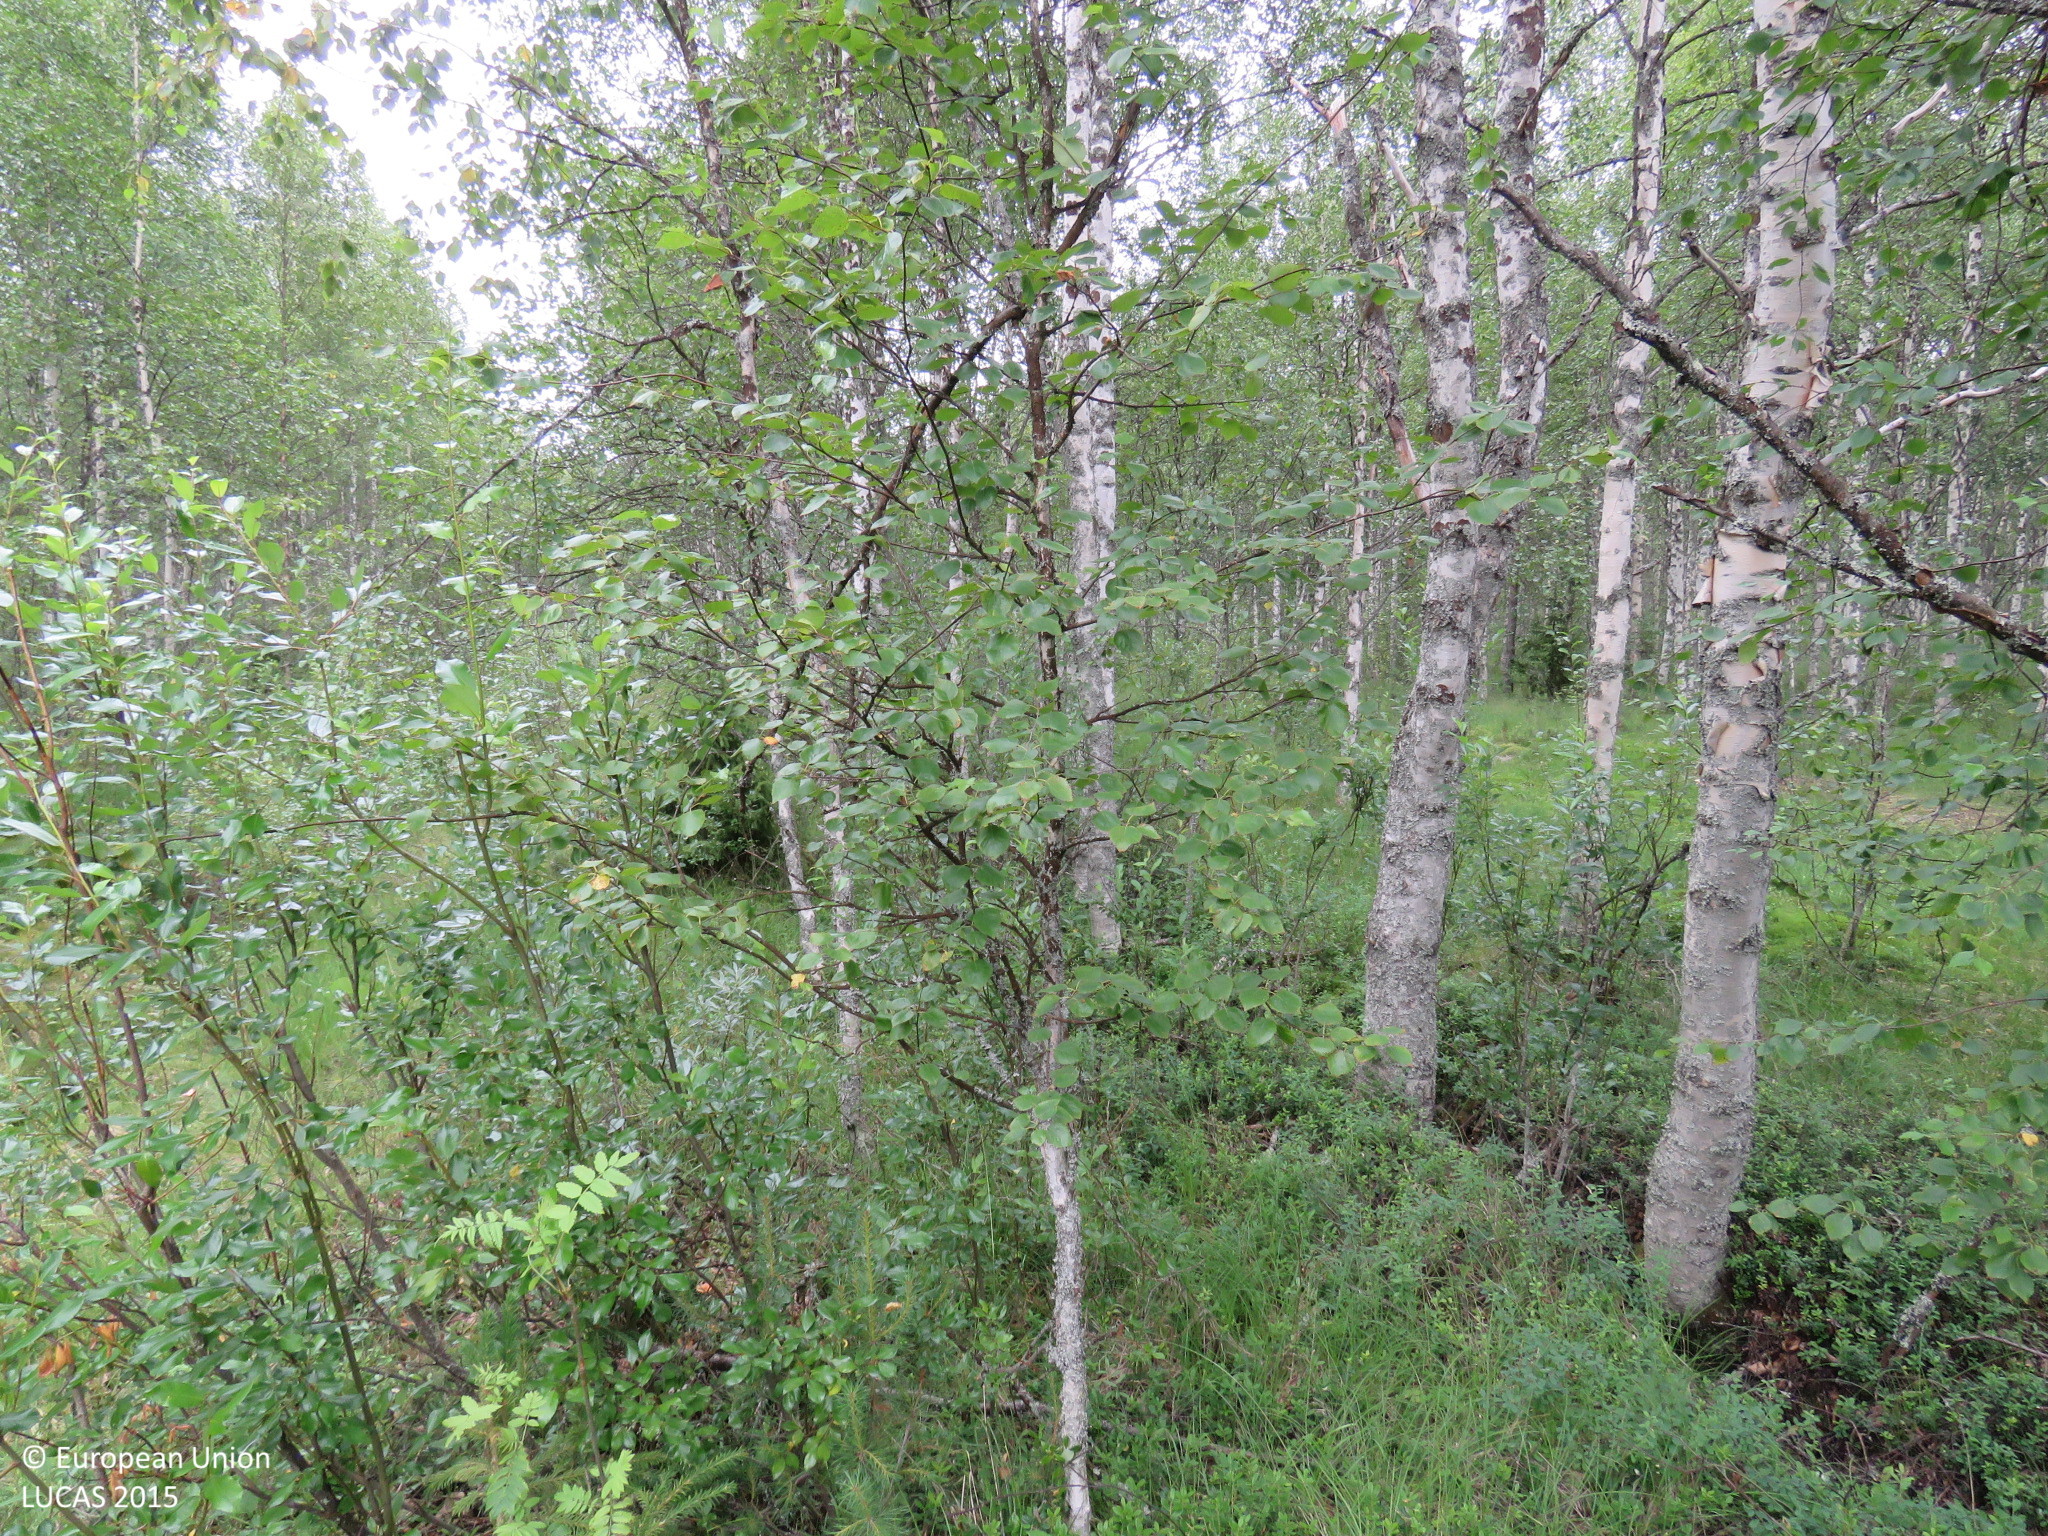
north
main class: Woodland
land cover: Broadleaved woodland
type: mire and swamp forests
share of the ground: 50 - 75 %
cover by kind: broadleaved forest trees 50 %, shrubs 20 %, herbaceous plants 20 %, coniferous forest trees 10 %
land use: Forestry
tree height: > 5 m
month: July
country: FI
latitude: 64.5954
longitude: 26.7281
